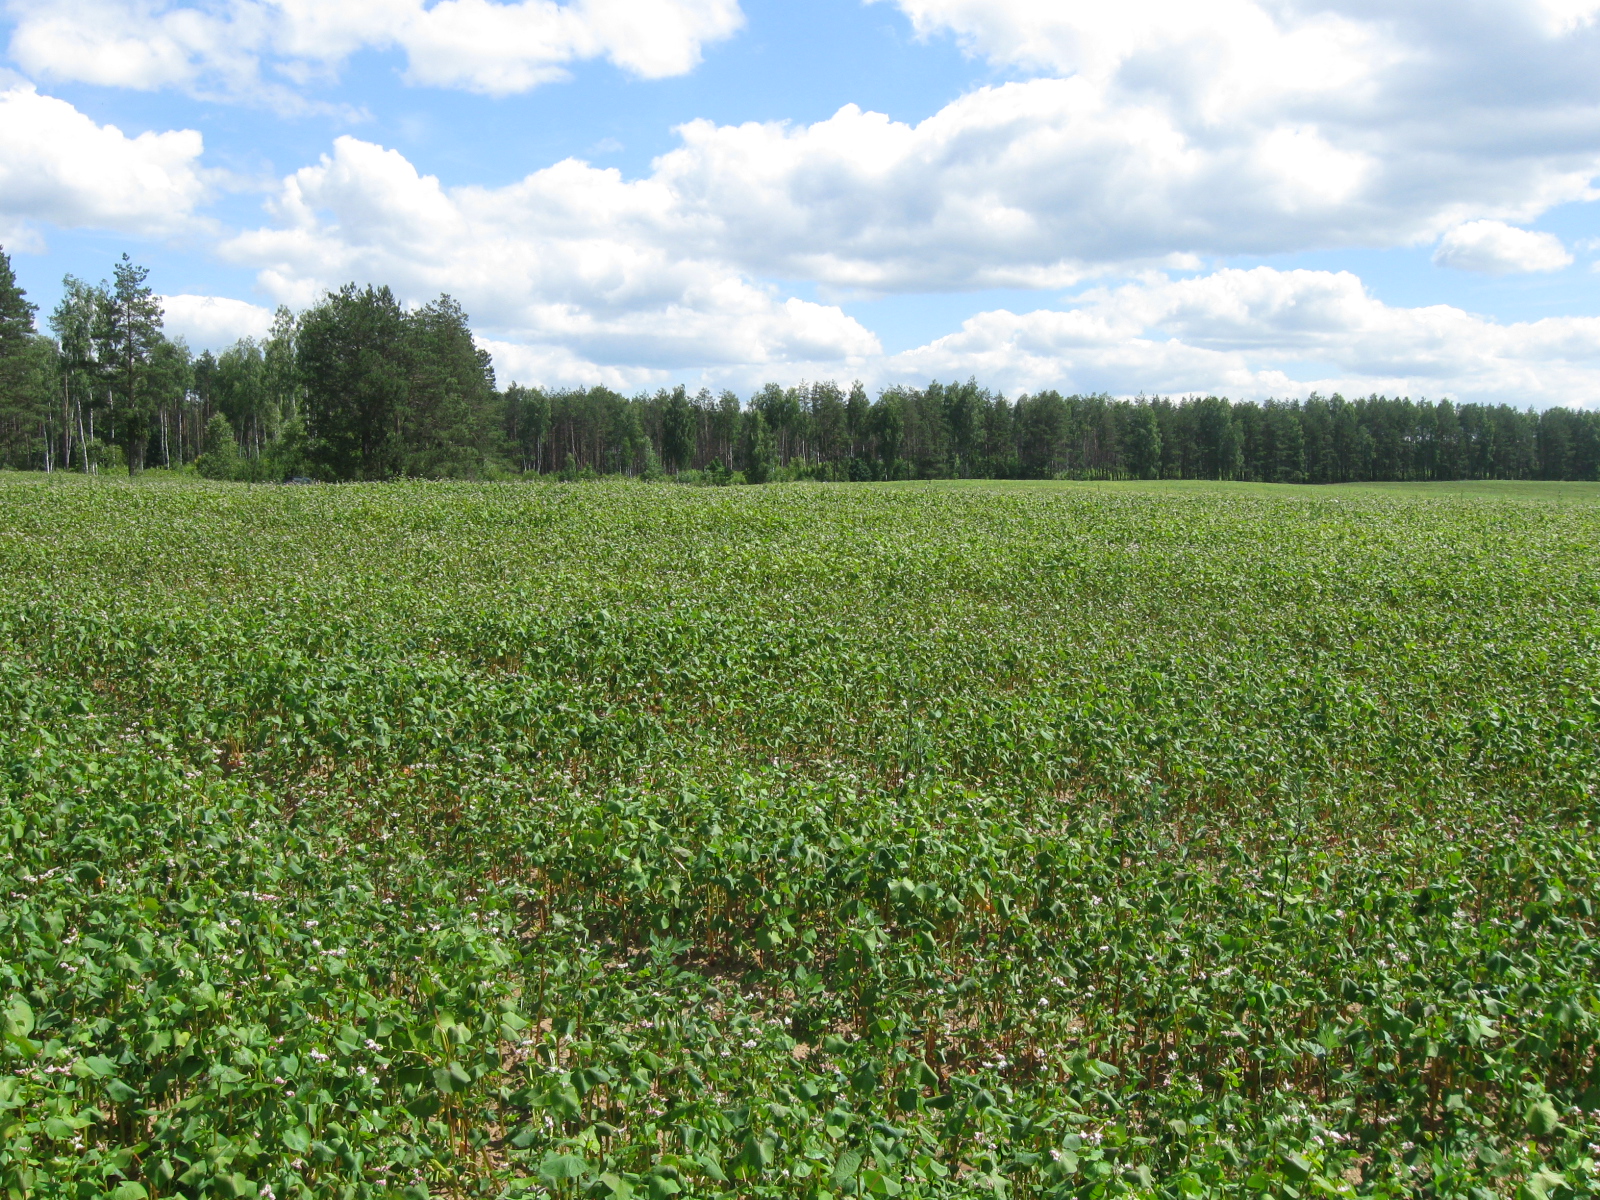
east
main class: Cropland
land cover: Other cereals
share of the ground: > 75 %
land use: Agriculture (excluding fallow land and kitchen gardens)
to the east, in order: Other cereals; Grass margins; Paved roads, cycling and walking lanes; Grass margins; Other cereals
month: July
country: LT
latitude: 54.3385
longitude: 24.6099
